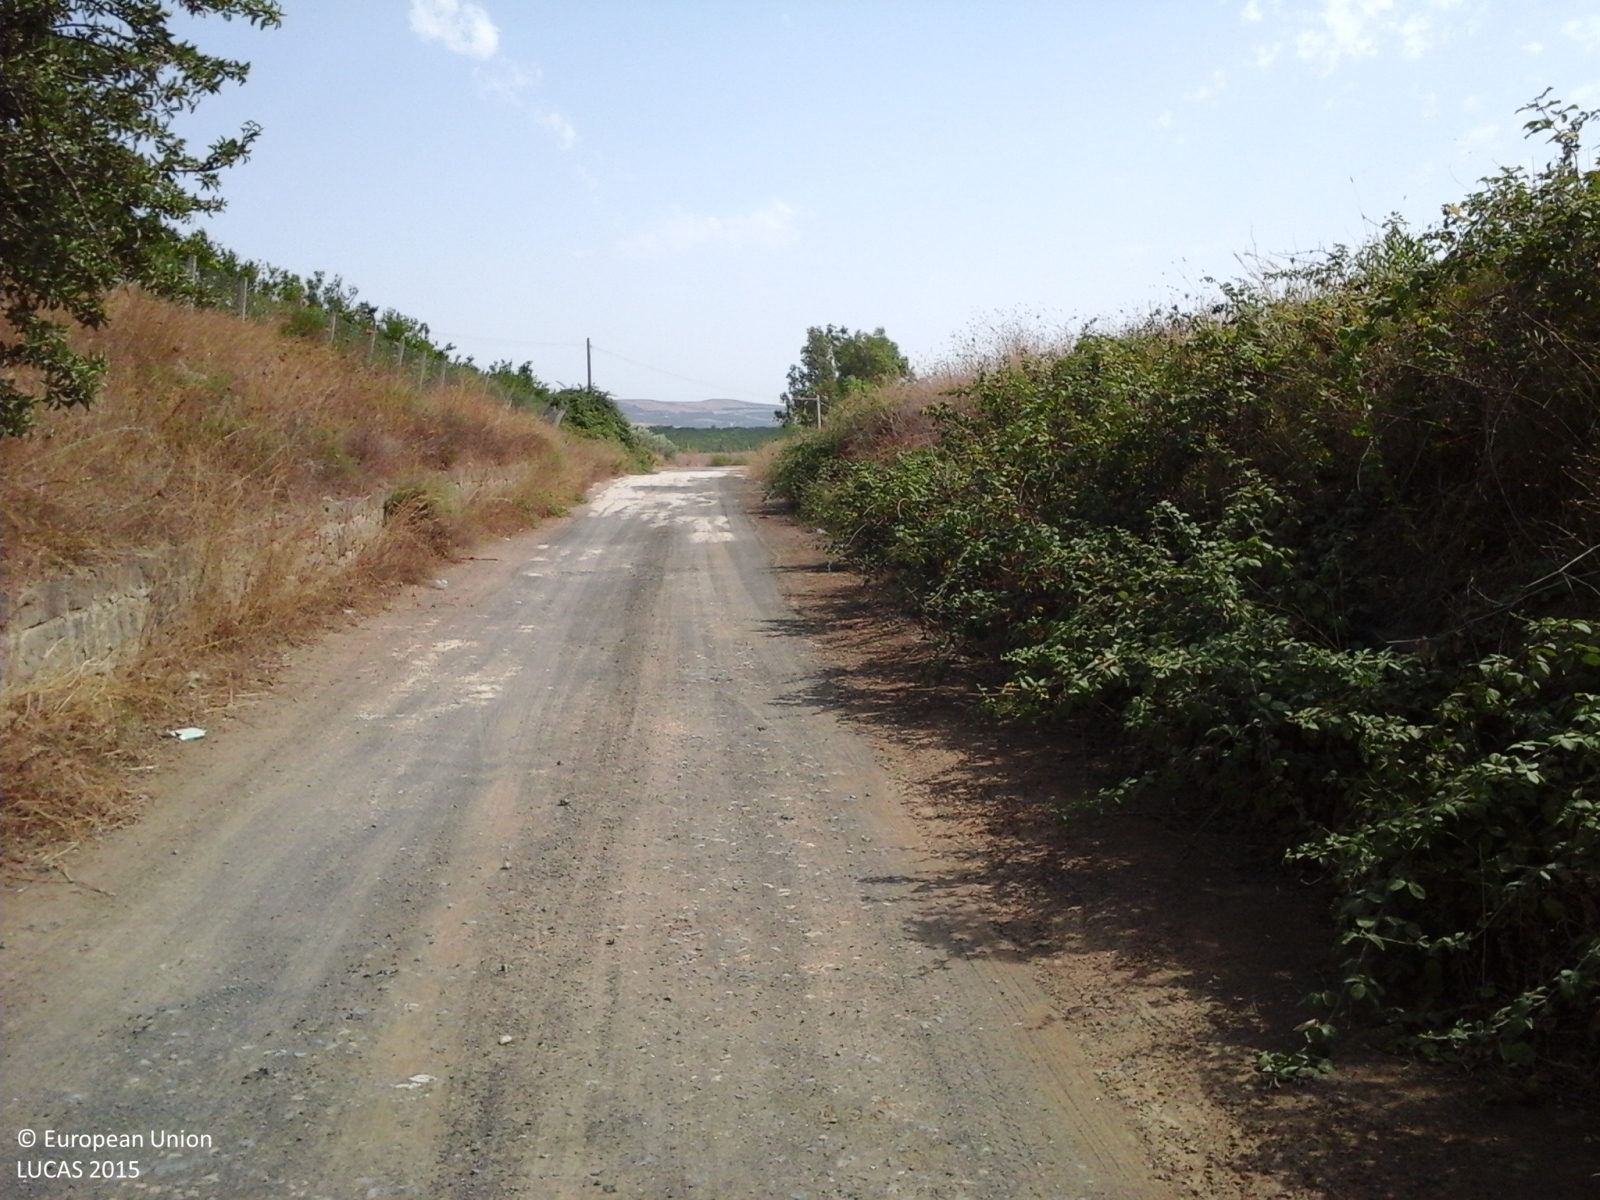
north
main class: Cropland
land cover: Oranges
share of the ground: > 75 %
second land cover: Spontaneously vegetated surfaces
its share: > 75 %
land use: Agriculture (excluding fallow land and kitchen gardens)
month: August
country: IT
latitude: 37.2784
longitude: 14.8471
